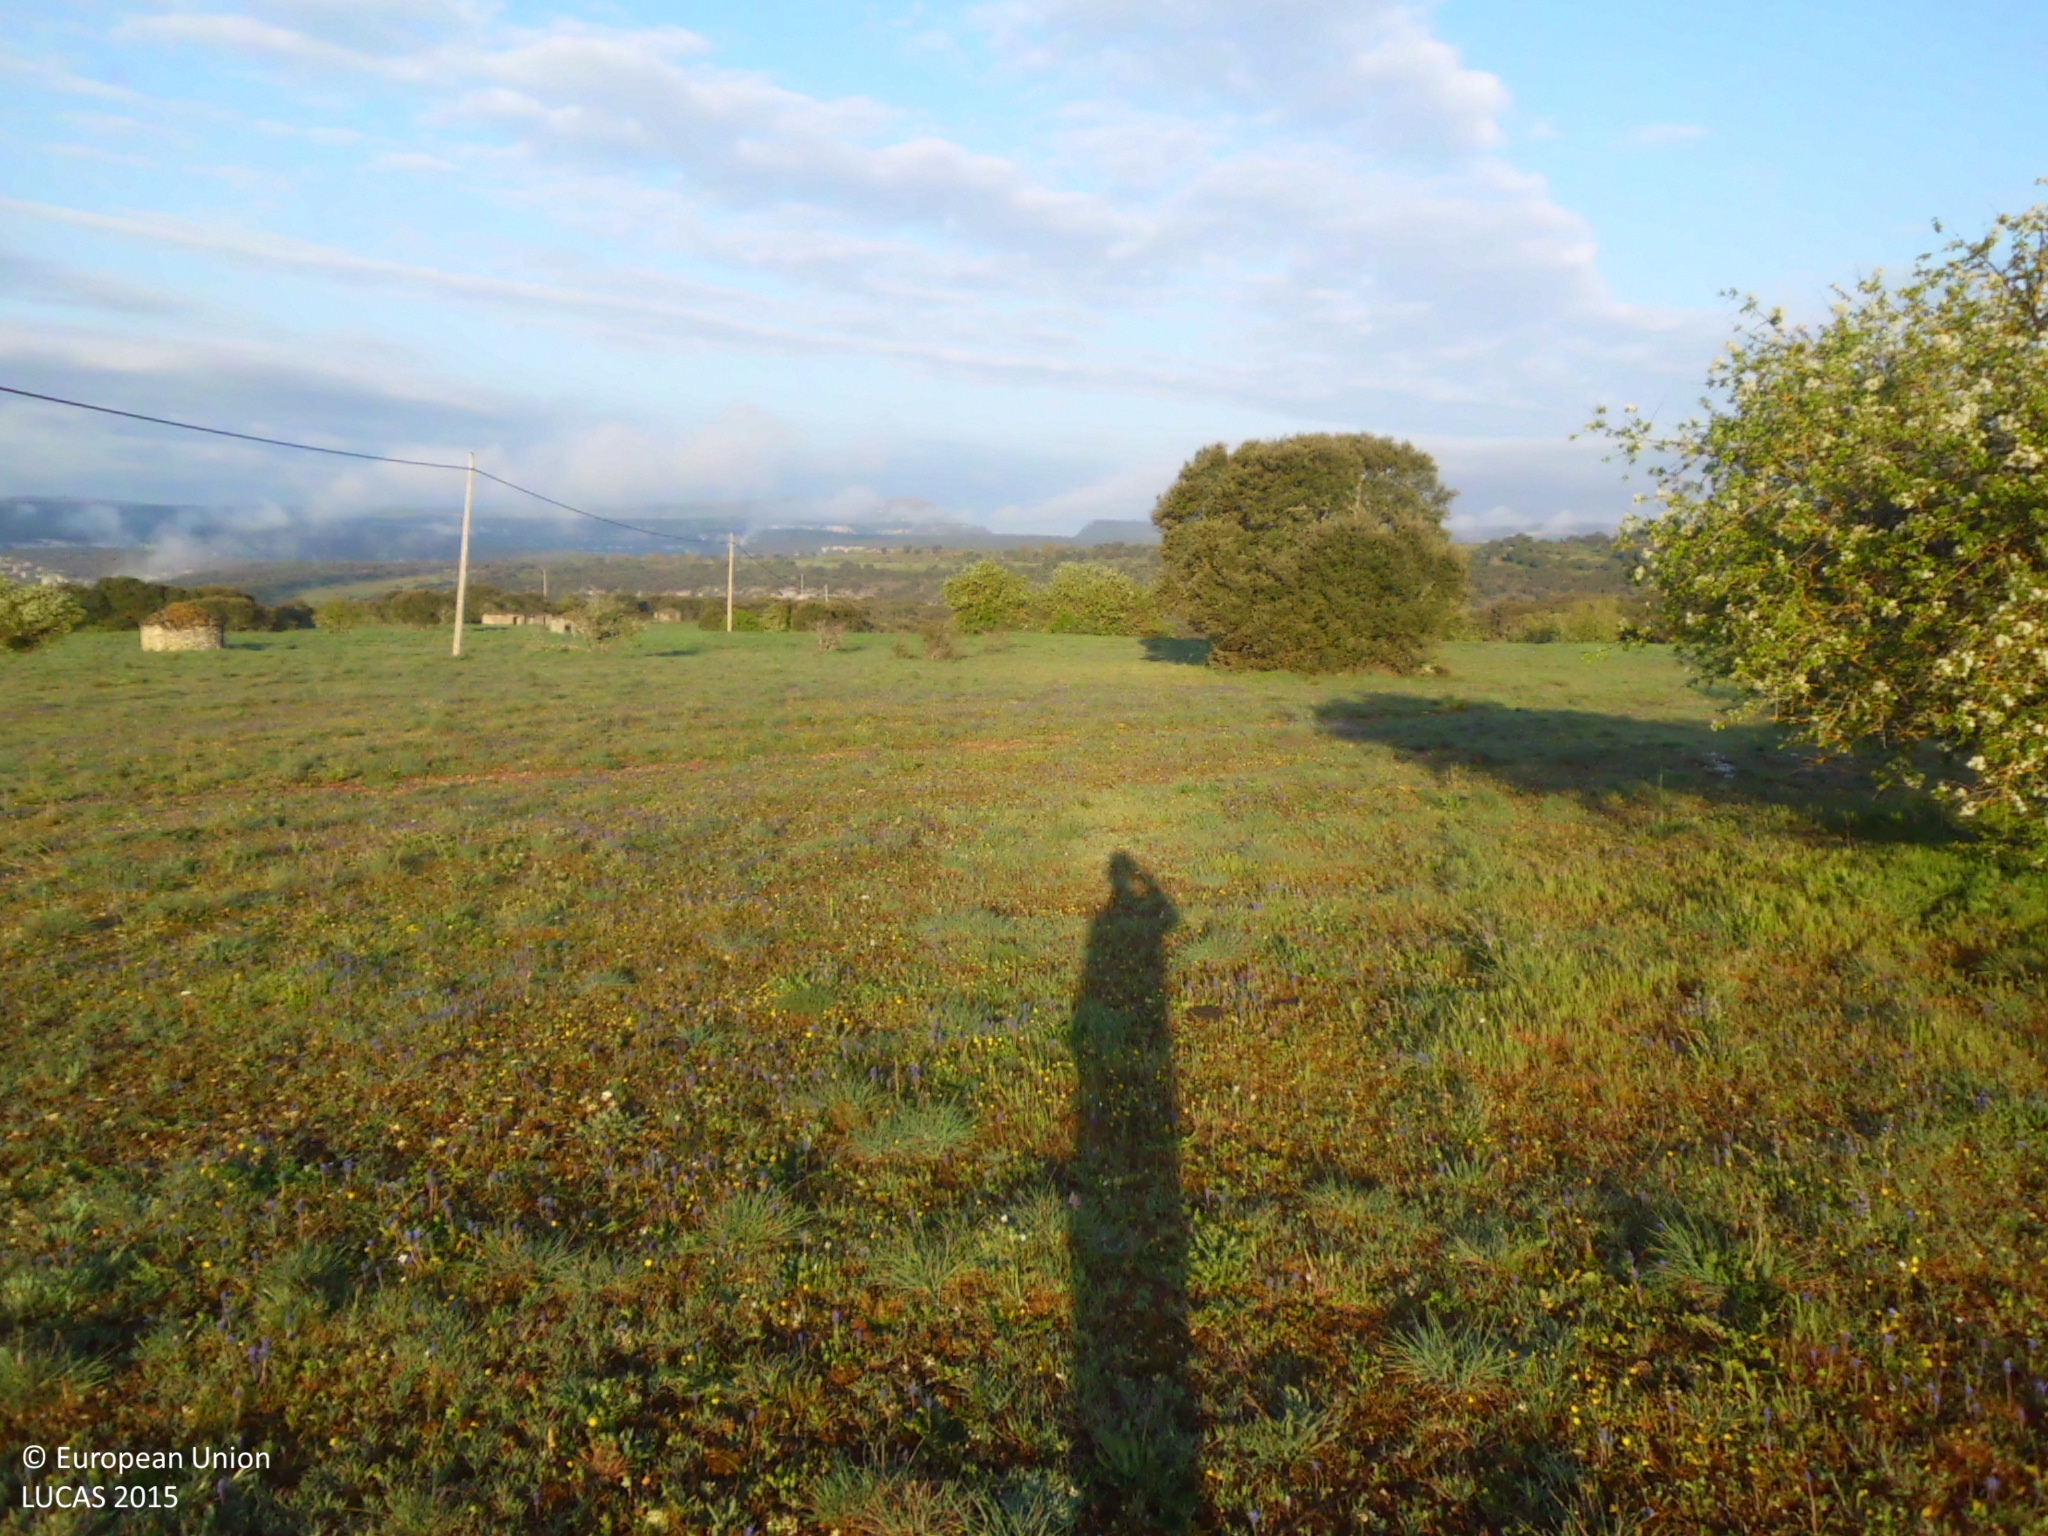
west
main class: Grassland
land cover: Grassland without tree/shrub cover
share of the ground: > 75 %
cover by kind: herbaceous plants 95 %, shrubs 5 %
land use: Abandoned areas
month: April
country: ES
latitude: 42.8407
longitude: -3.7828
